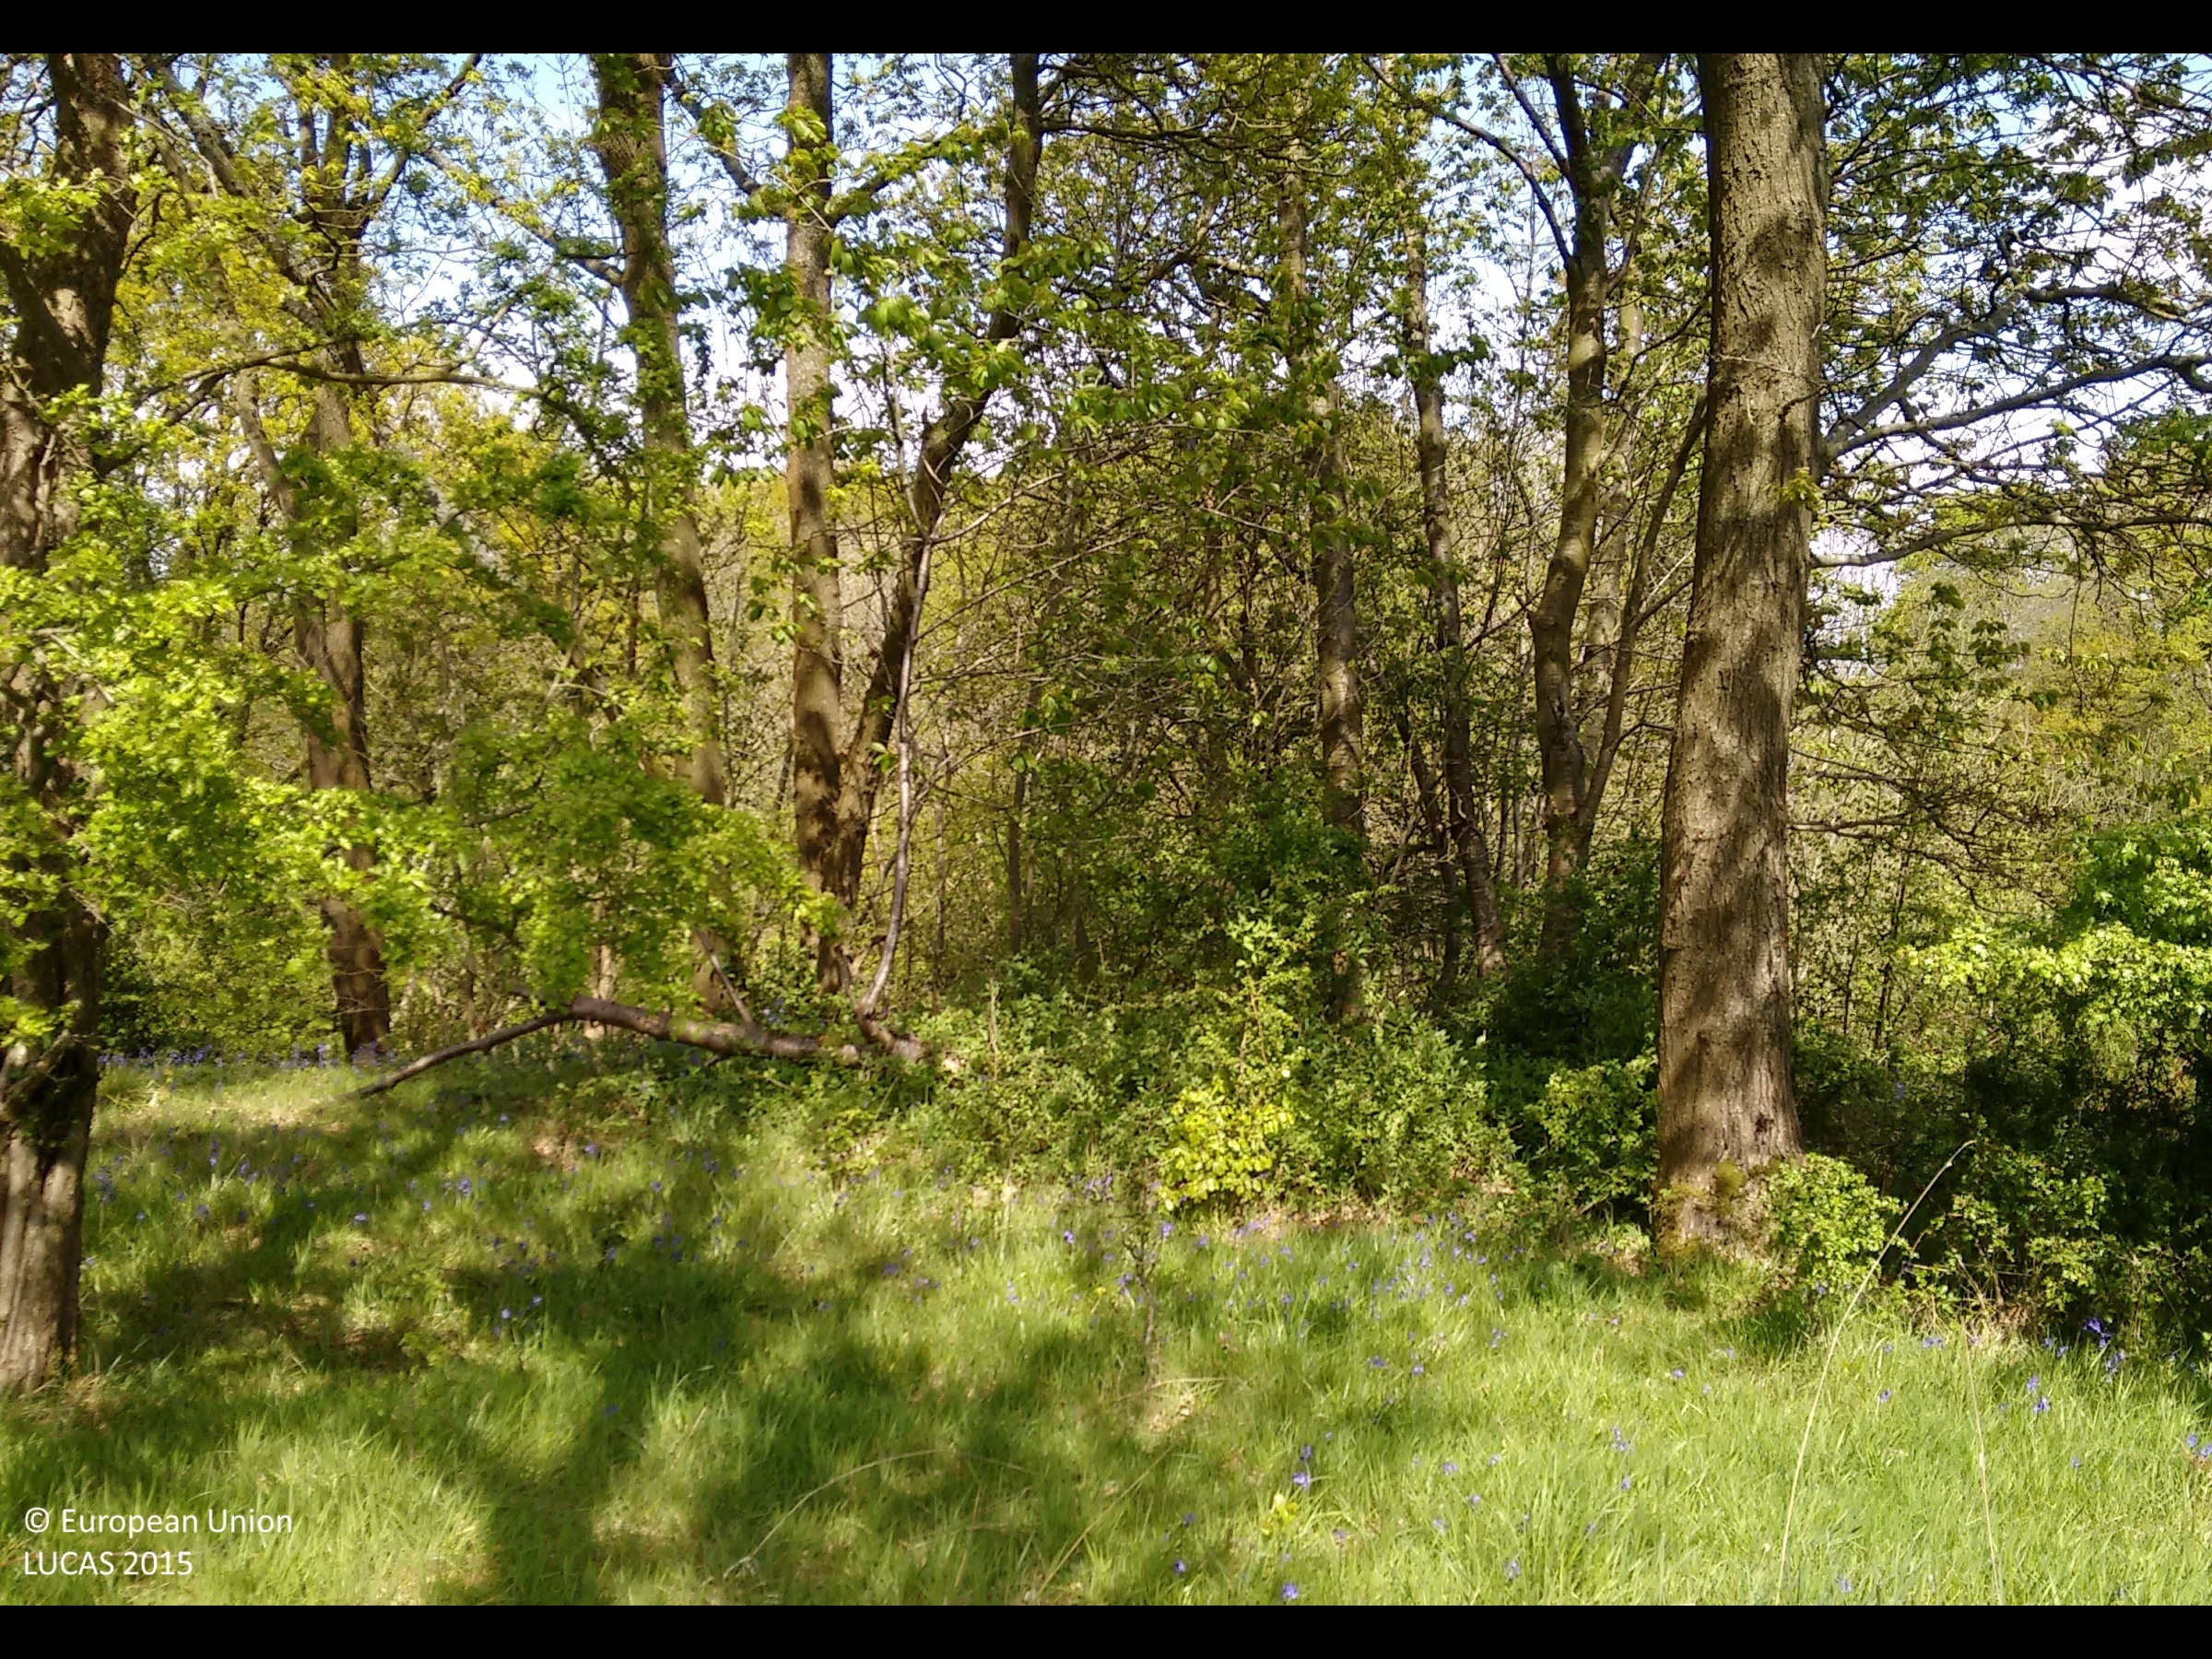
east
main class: Woodland
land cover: Broadleaved woodland
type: mesophytic deciduous forest
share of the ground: > 75 %
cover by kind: broadleaved forest trees 100 %
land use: Semi-natural and natural areas not in use
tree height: > 5 m
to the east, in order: Broadleaved woodland; Fences; Broadleaved woodland; Rivers and streams; Broadleaved woodland; Electric lines; Broadleaved woodland; Grassland without tree/shrub cover
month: May
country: GB
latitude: 53.7943
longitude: -2.6217
